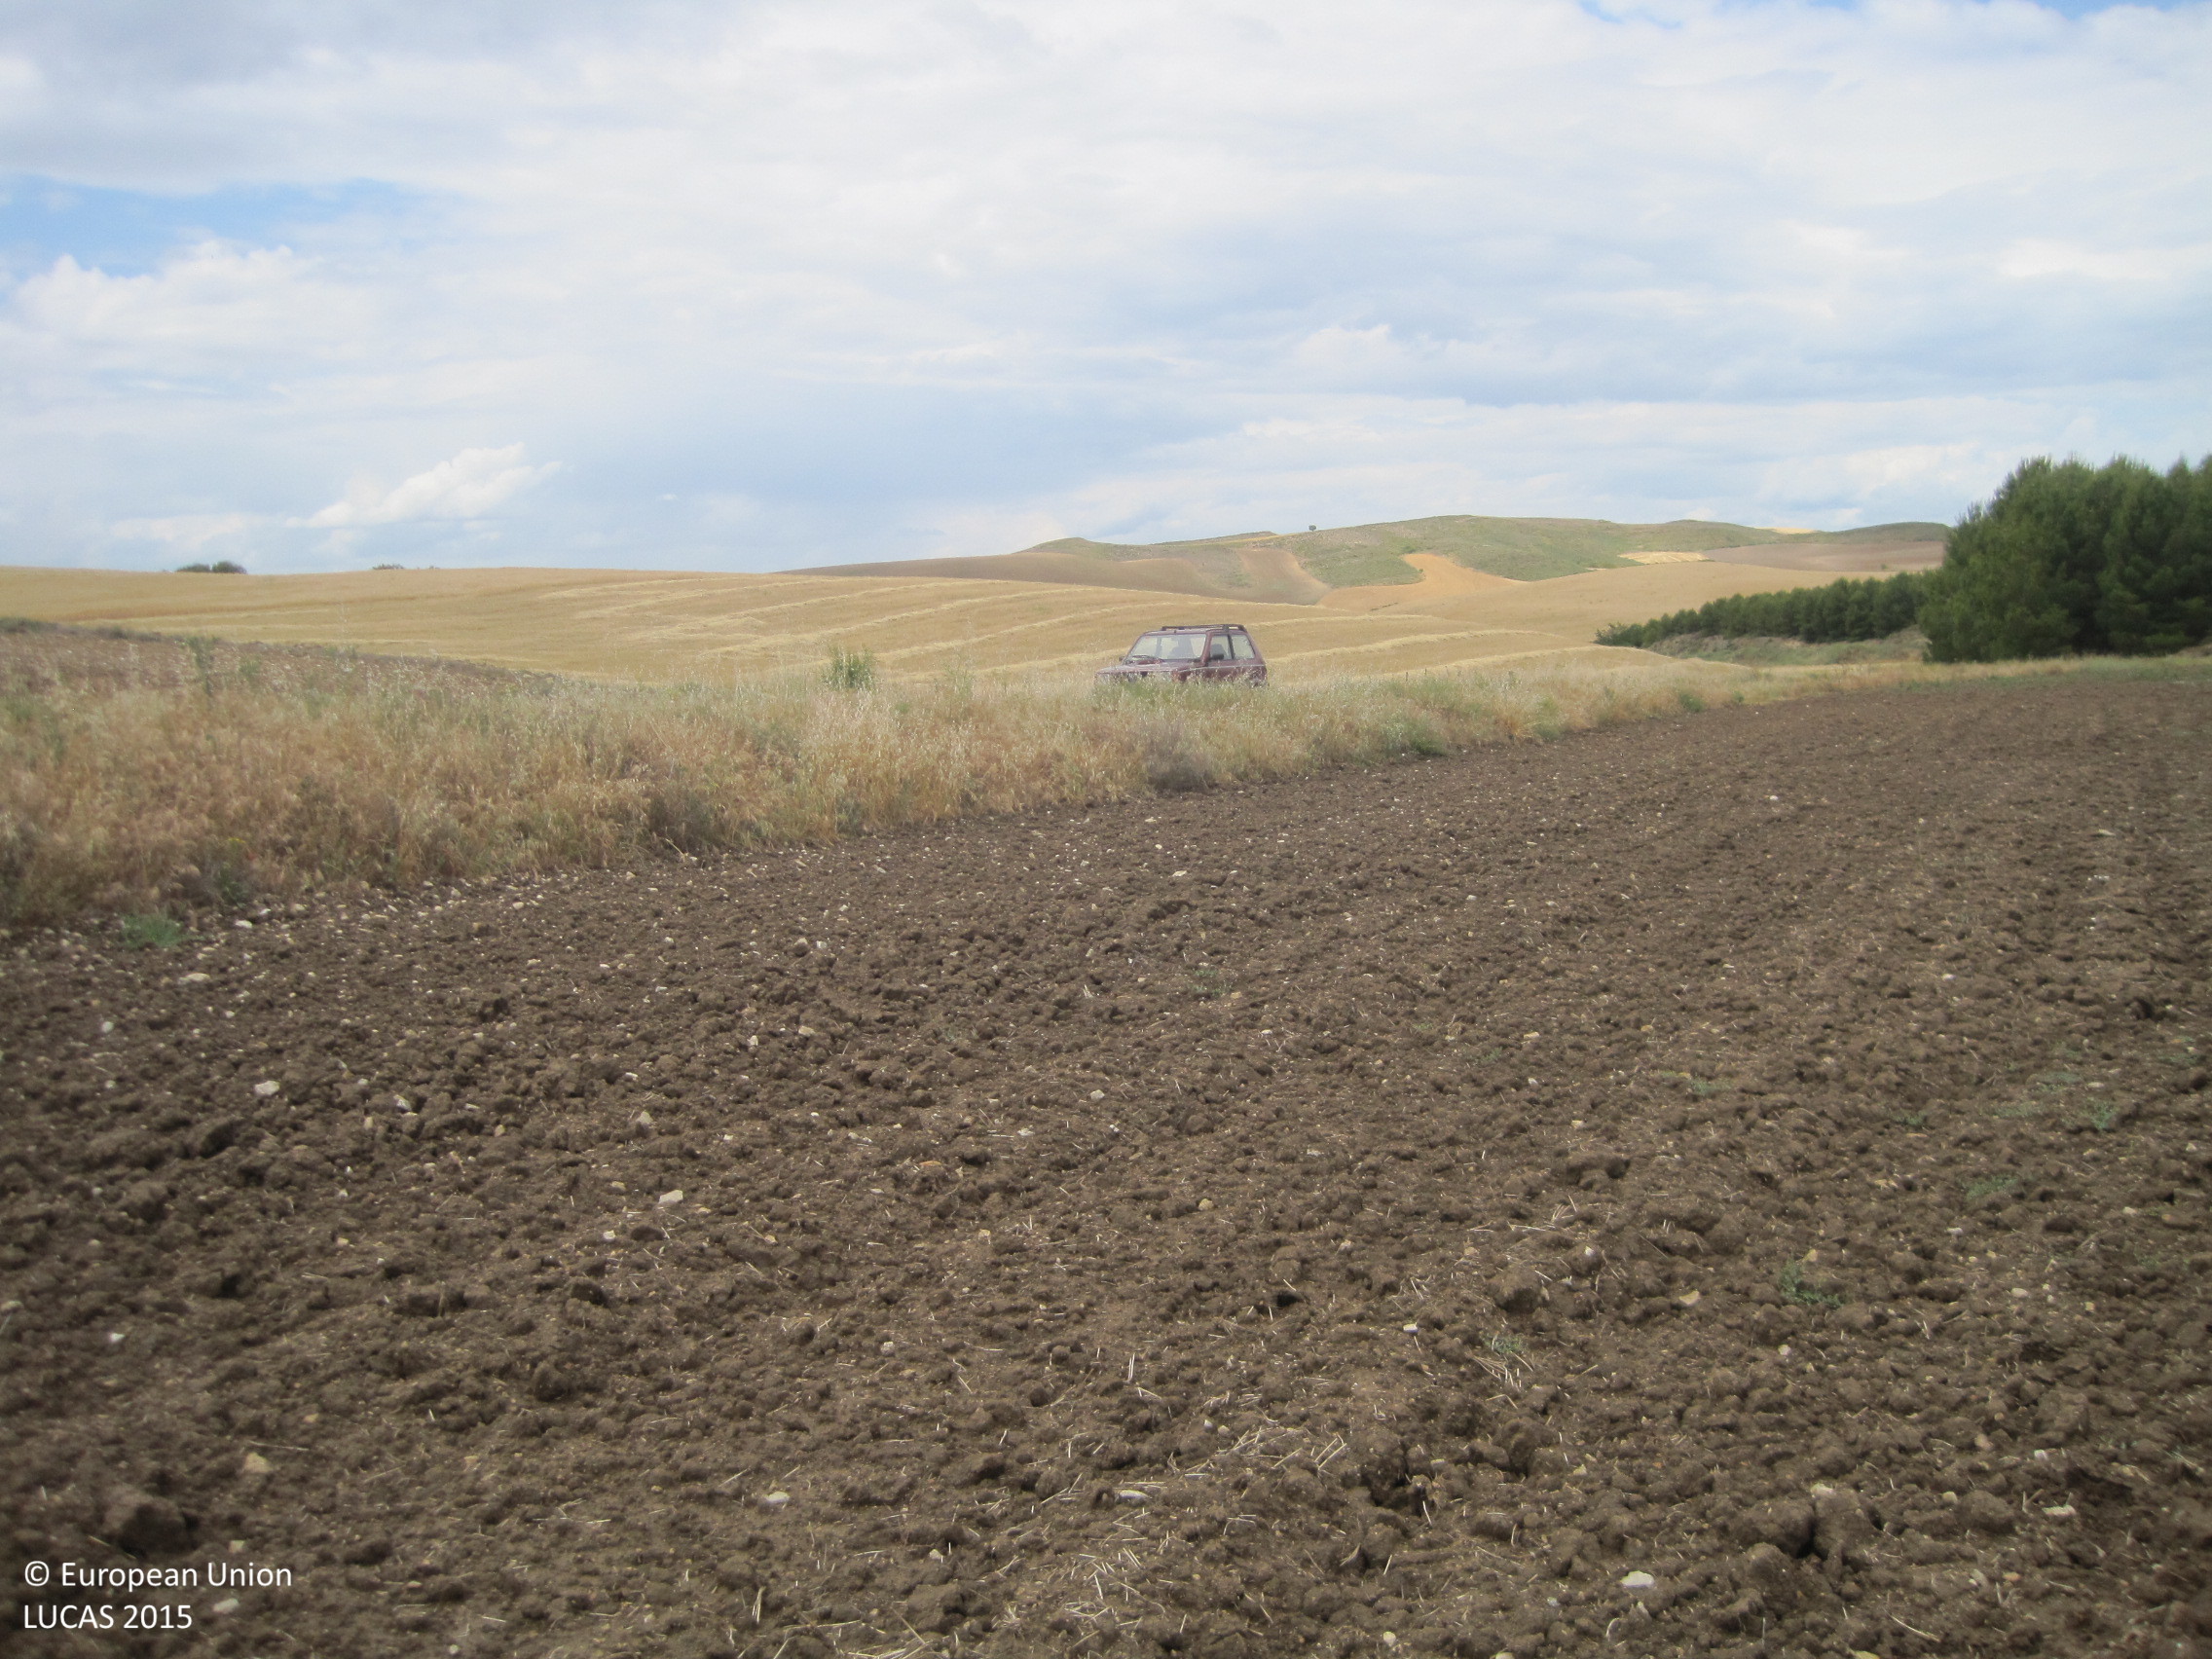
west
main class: Grassland
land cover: Spontaneously vegetated surfaces
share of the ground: 10 - 25 %
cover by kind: unconsolidated bare surface 90 %, herbaceous plants 10 %
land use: Fallow land
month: June
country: ES
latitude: 42.5034
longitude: -2.1500
